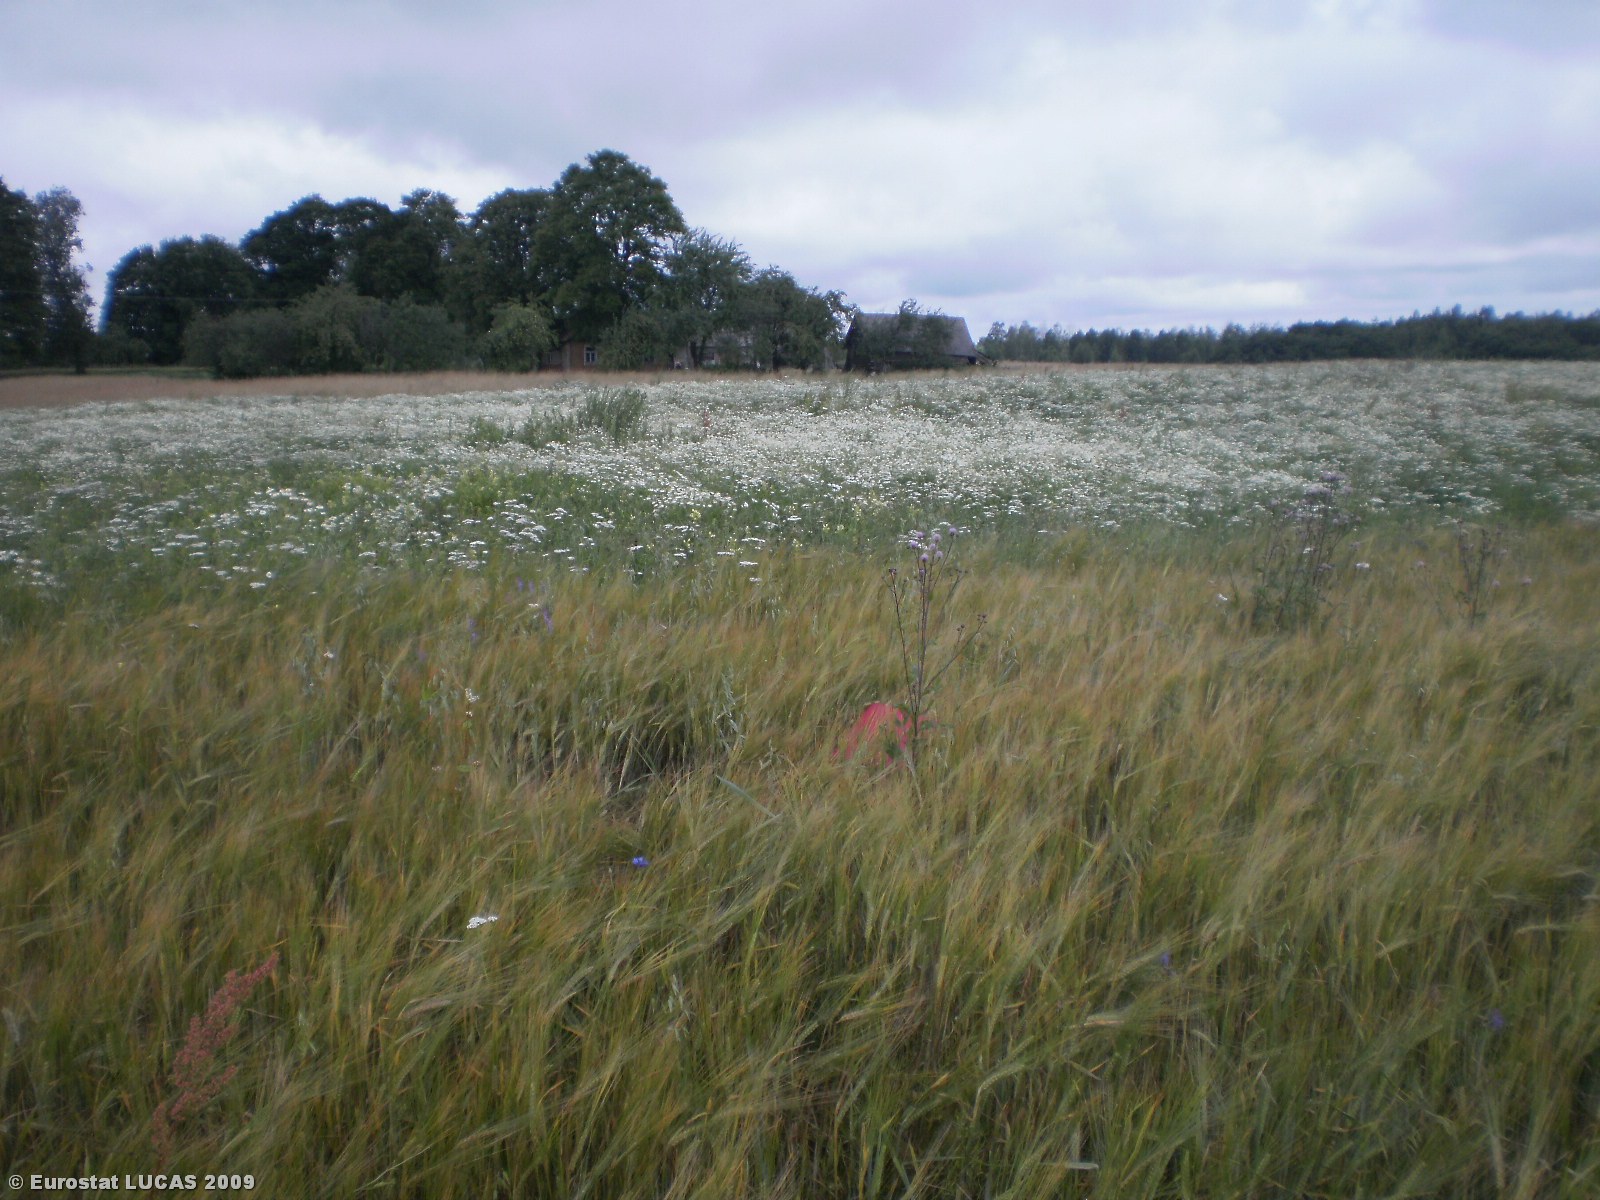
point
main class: Cropland
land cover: Barley
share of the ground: > 75 %
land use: Agriculture (excluding fallow land and kitchen gardens)
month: July
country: LT
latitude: 56.0658
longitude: 25.3285
